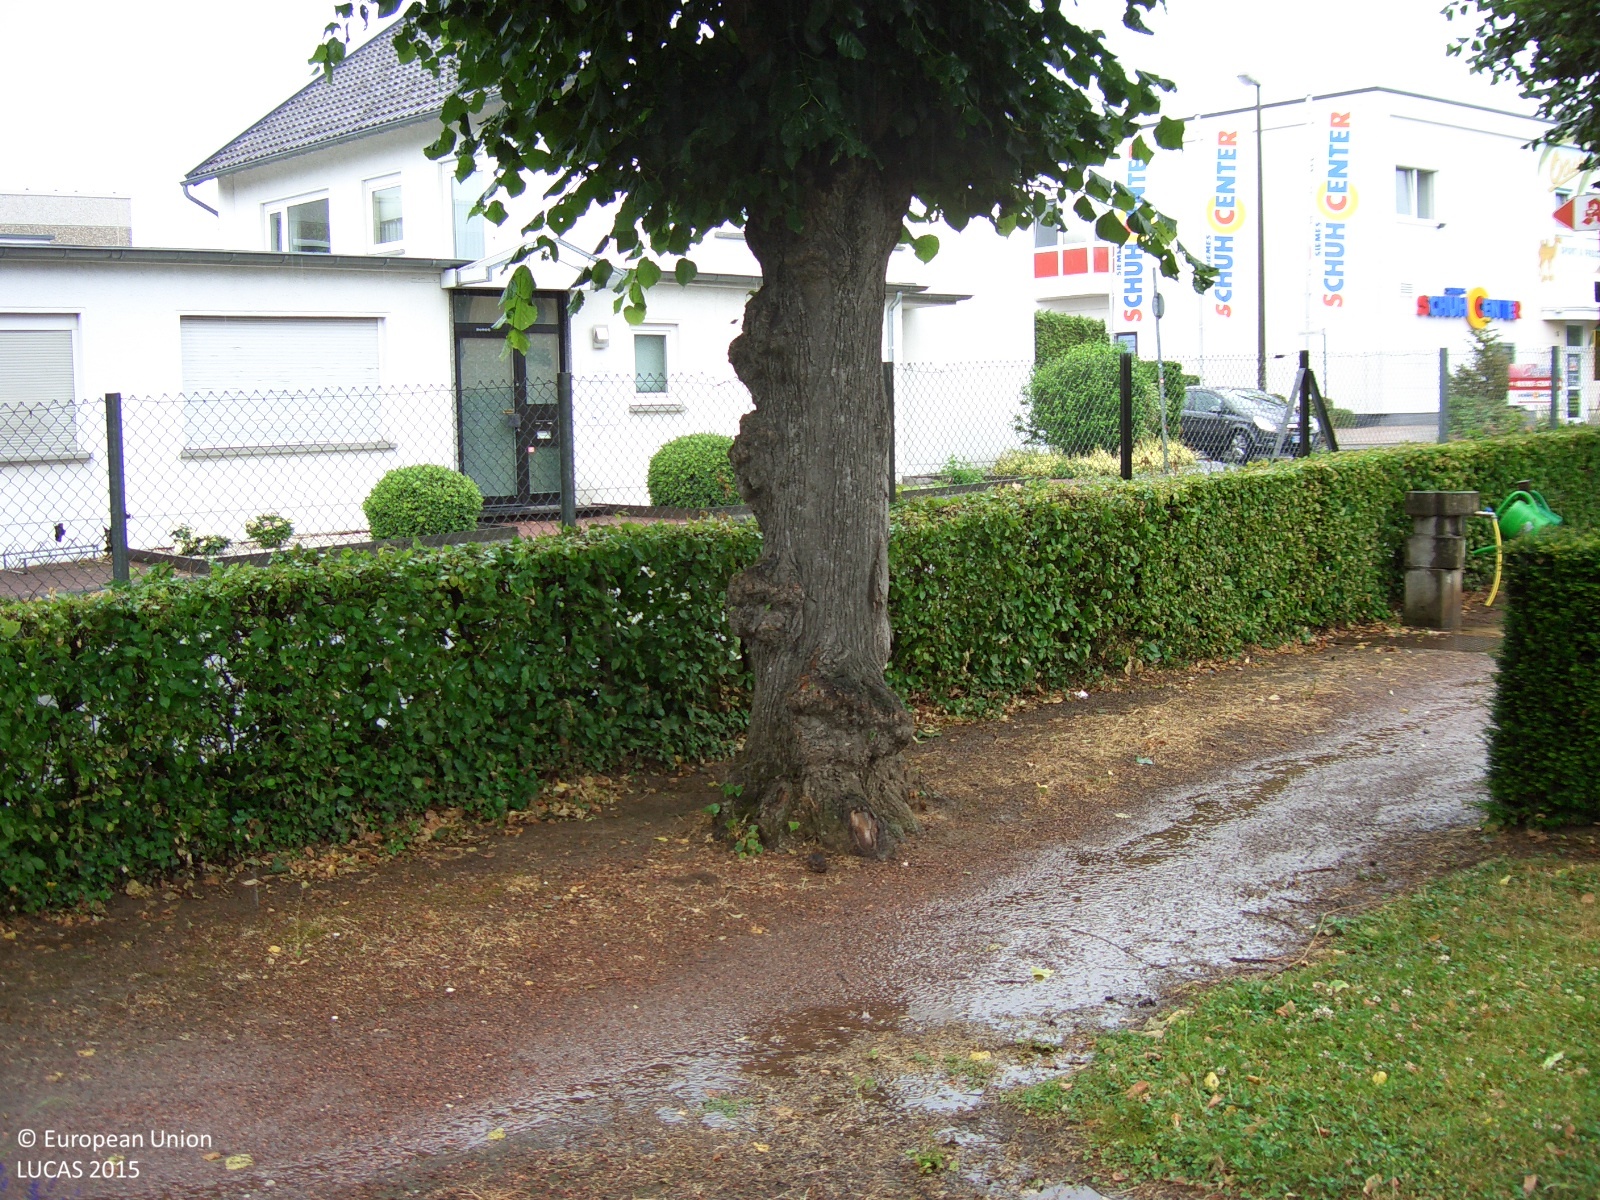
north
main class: Woodland
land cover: Broadleaved woodland
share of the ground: 25 - 50 %
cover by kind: broadleaved forest trees 50 %, herbaceous plants 30 %, shrubs 20 %
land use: Community services
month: June
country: DE
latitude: 50.7568
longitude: 7.0090
